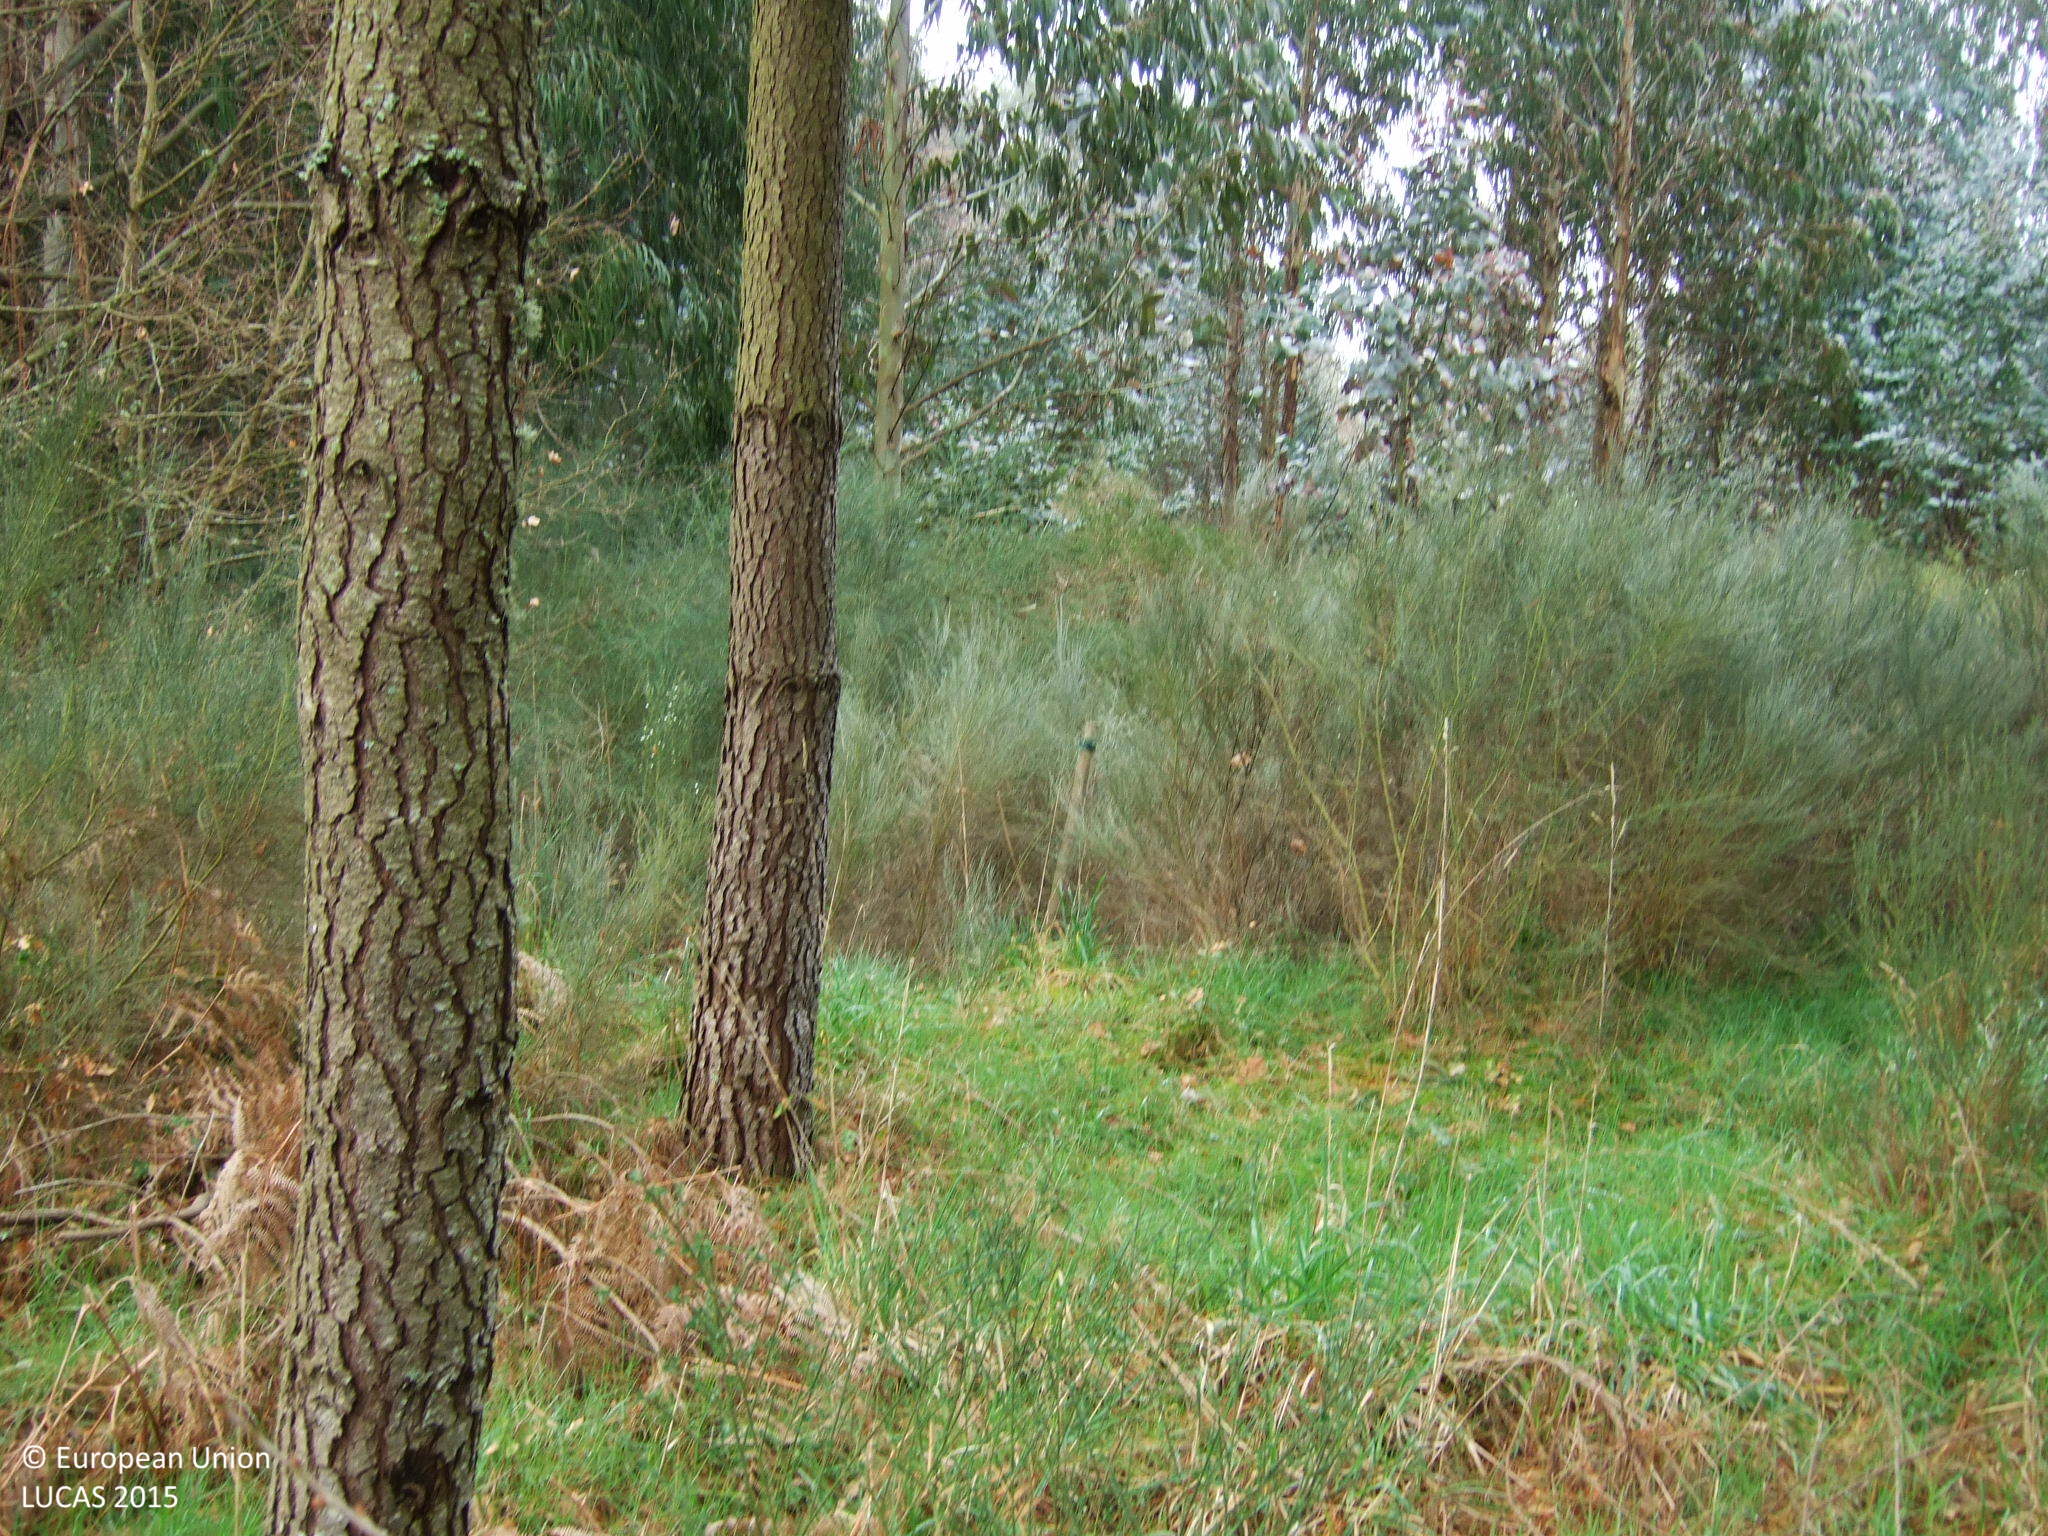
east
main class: Woodland
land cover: Pine dominated coniferous woodland
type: exotic forest
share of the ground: > 75 %
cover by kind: coniferous forest trees 90 %, shrubs 10 %
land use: Forestry
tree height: > 5 m
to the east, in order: Pine dominated coniferous woodland; Broadleaved woodland; Pine dominated coniferous woodland; Fences; Grassland without tree/shrub cover; Fences; Tracks; Fences; Other bare soil; Grass margins; Dry stone walls; Tracks
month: March
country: ES
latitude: 42.8014
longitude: -7.8745
